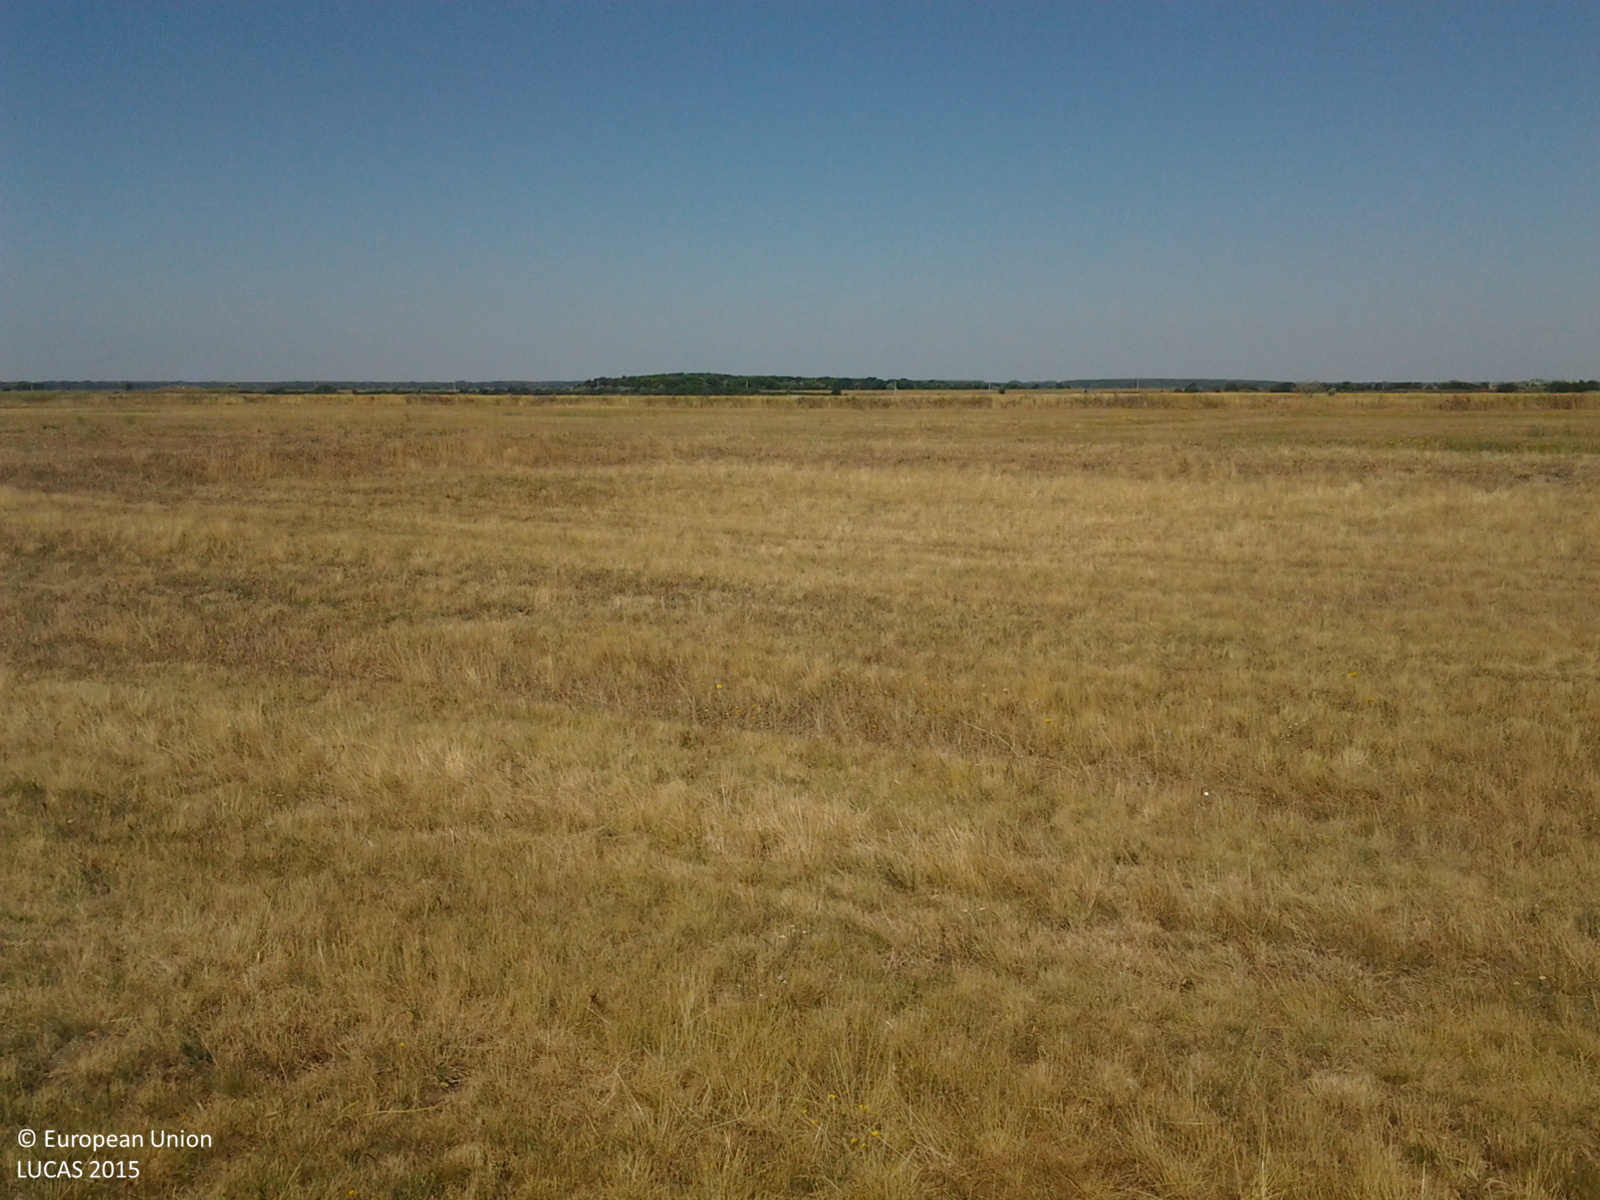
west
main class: Grassland
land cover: Grassland without tree/shrub cover
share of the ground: > 75 %
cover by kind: herbaceous plants 100 %
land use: Agriculture (excluding fallow land and kitchen gardens)
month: July
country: HU
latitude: 47.3372
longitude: 20.5255
